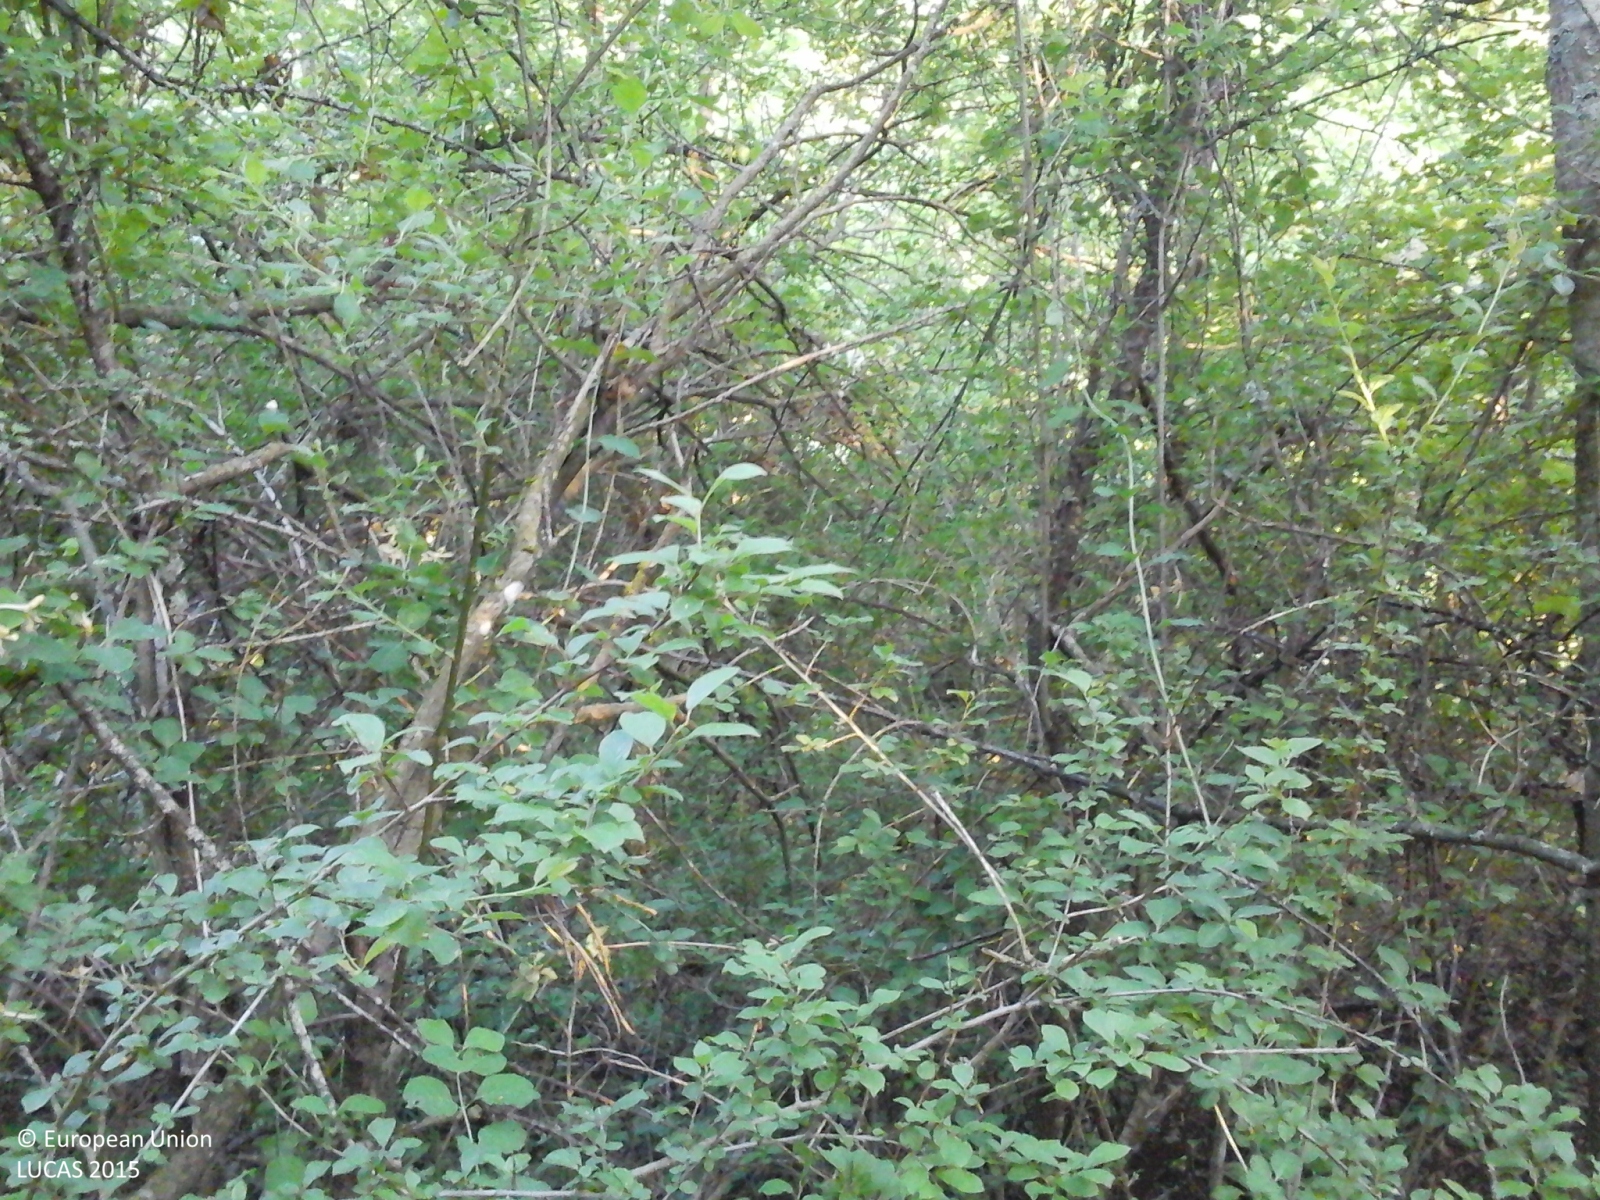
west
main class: Woodland
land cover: Broadleaved woodland
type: thermophilous deciduous forest
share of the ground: > 75 %
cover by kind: broadleaved forest trees 70 %, shrubs 30 %
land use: Forestry
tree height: > 5 m
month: May
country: IT
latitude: 44.5845
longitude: 9.6858
